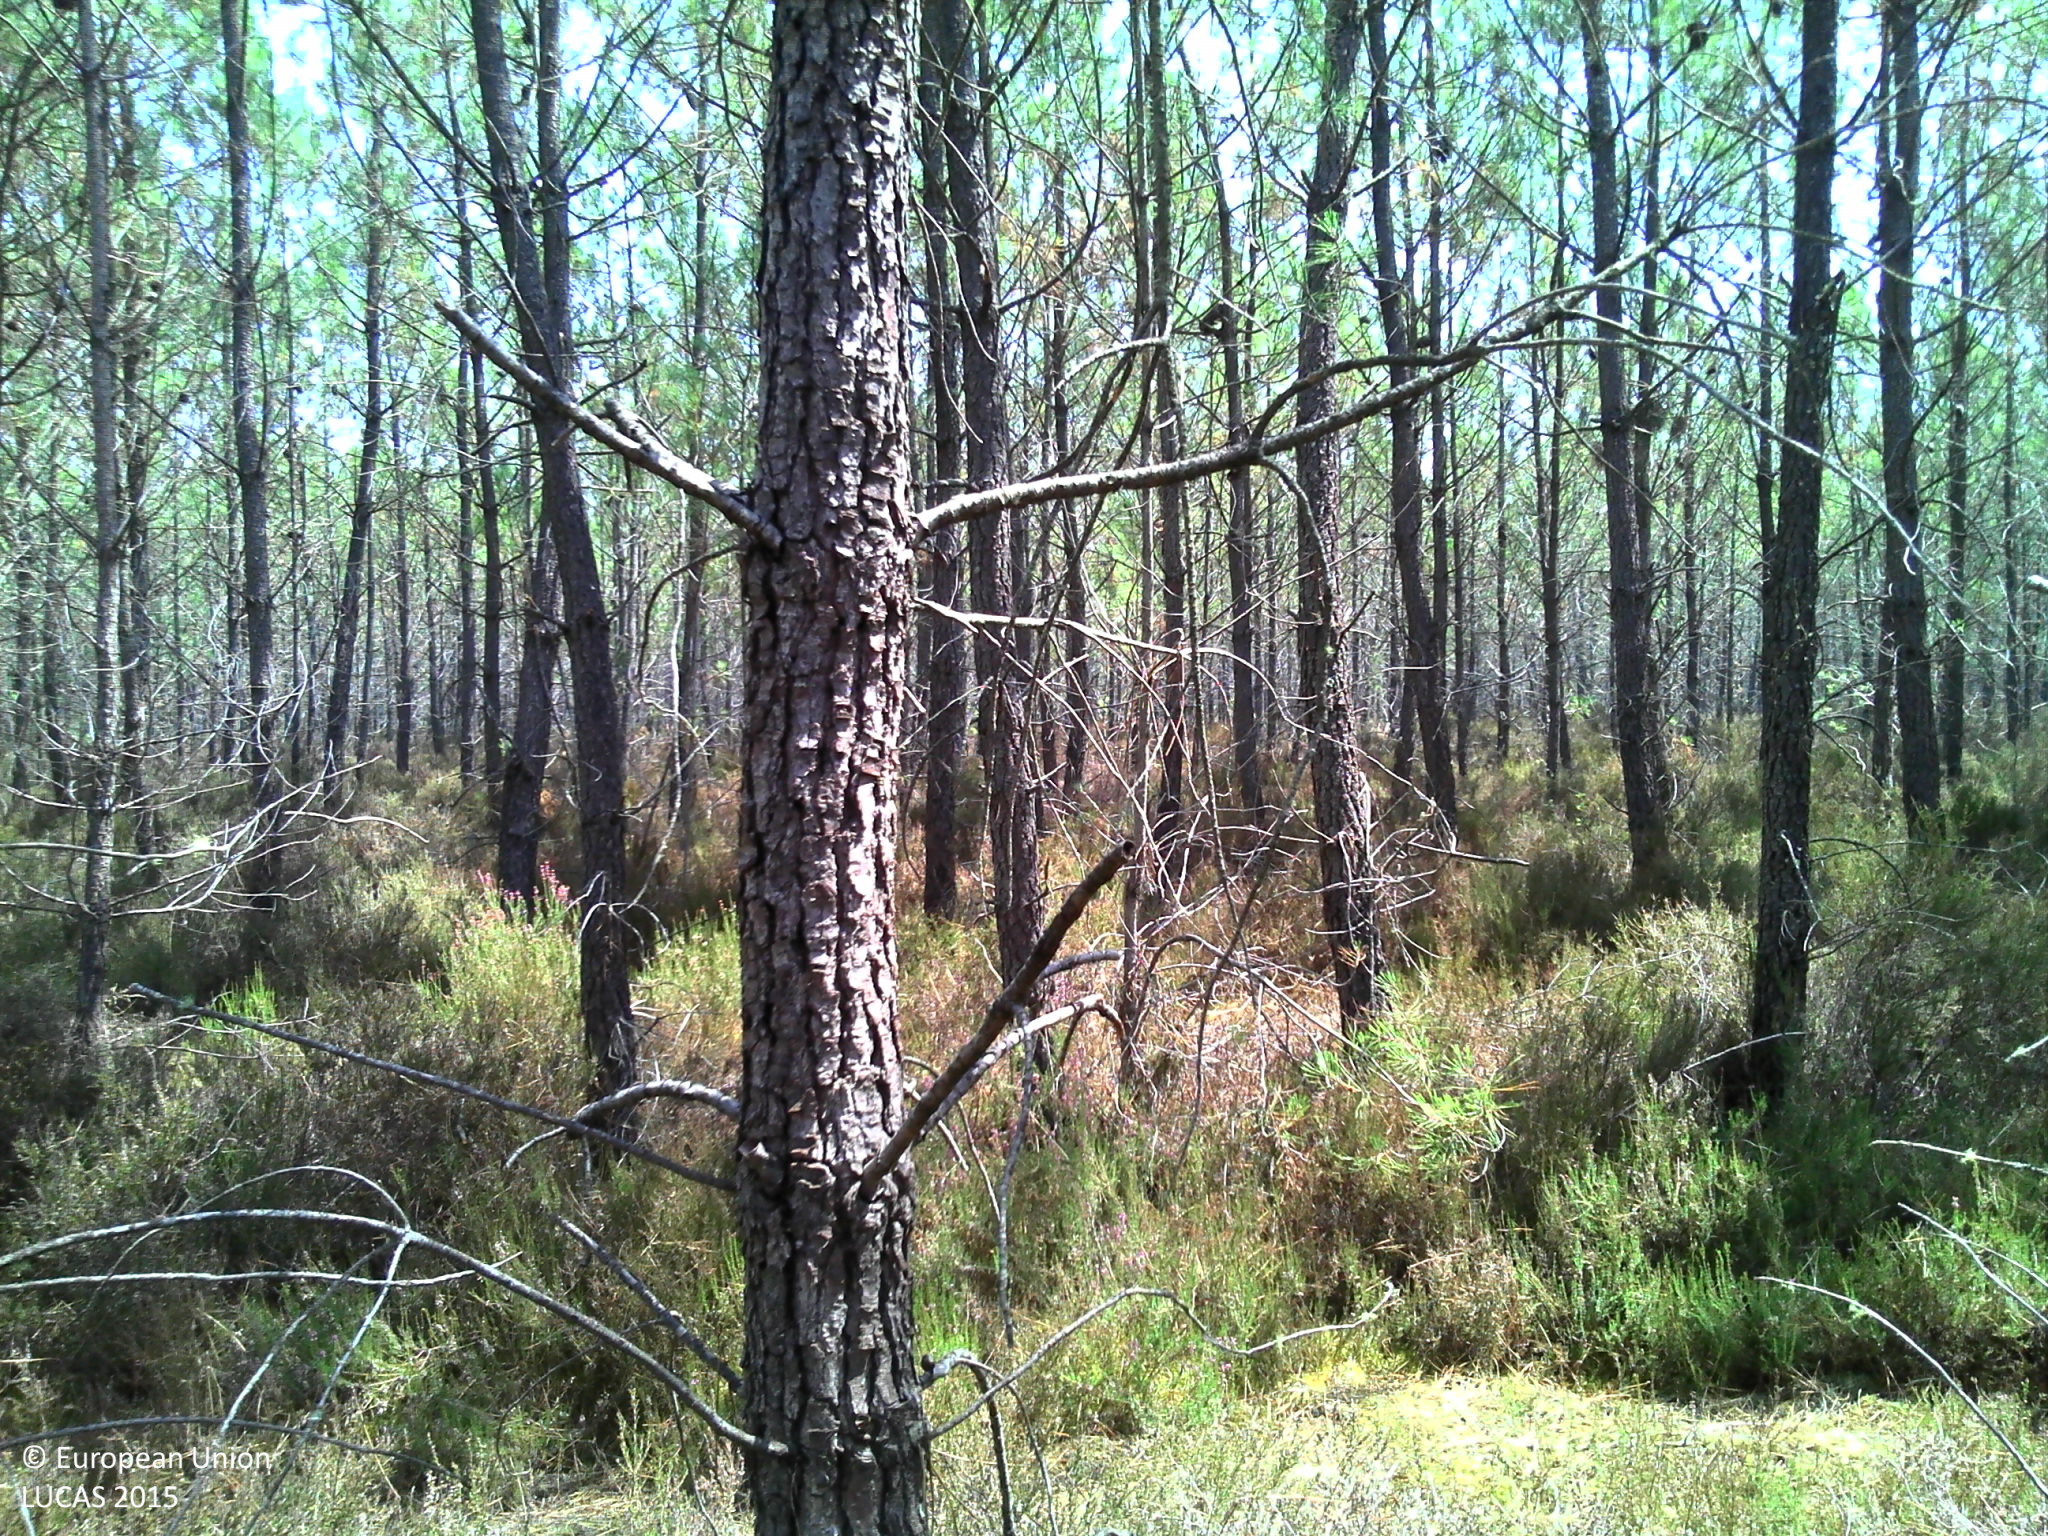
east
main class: Woodland
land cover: Pine dominated coniferous woodland
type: coniferous forest of the mediterranean region
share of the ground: > 75 %
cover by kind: coniferous forest trees 75 %, herbaceous plants 20 %, lichens and mosses 5 %
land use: Forestry
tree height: > 5 m
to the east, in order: Pine dominated coniferous woodland; Tracks; Pine dominated coniferous woodland
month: August
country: FR
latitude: 44.1577
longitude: -1.0599
